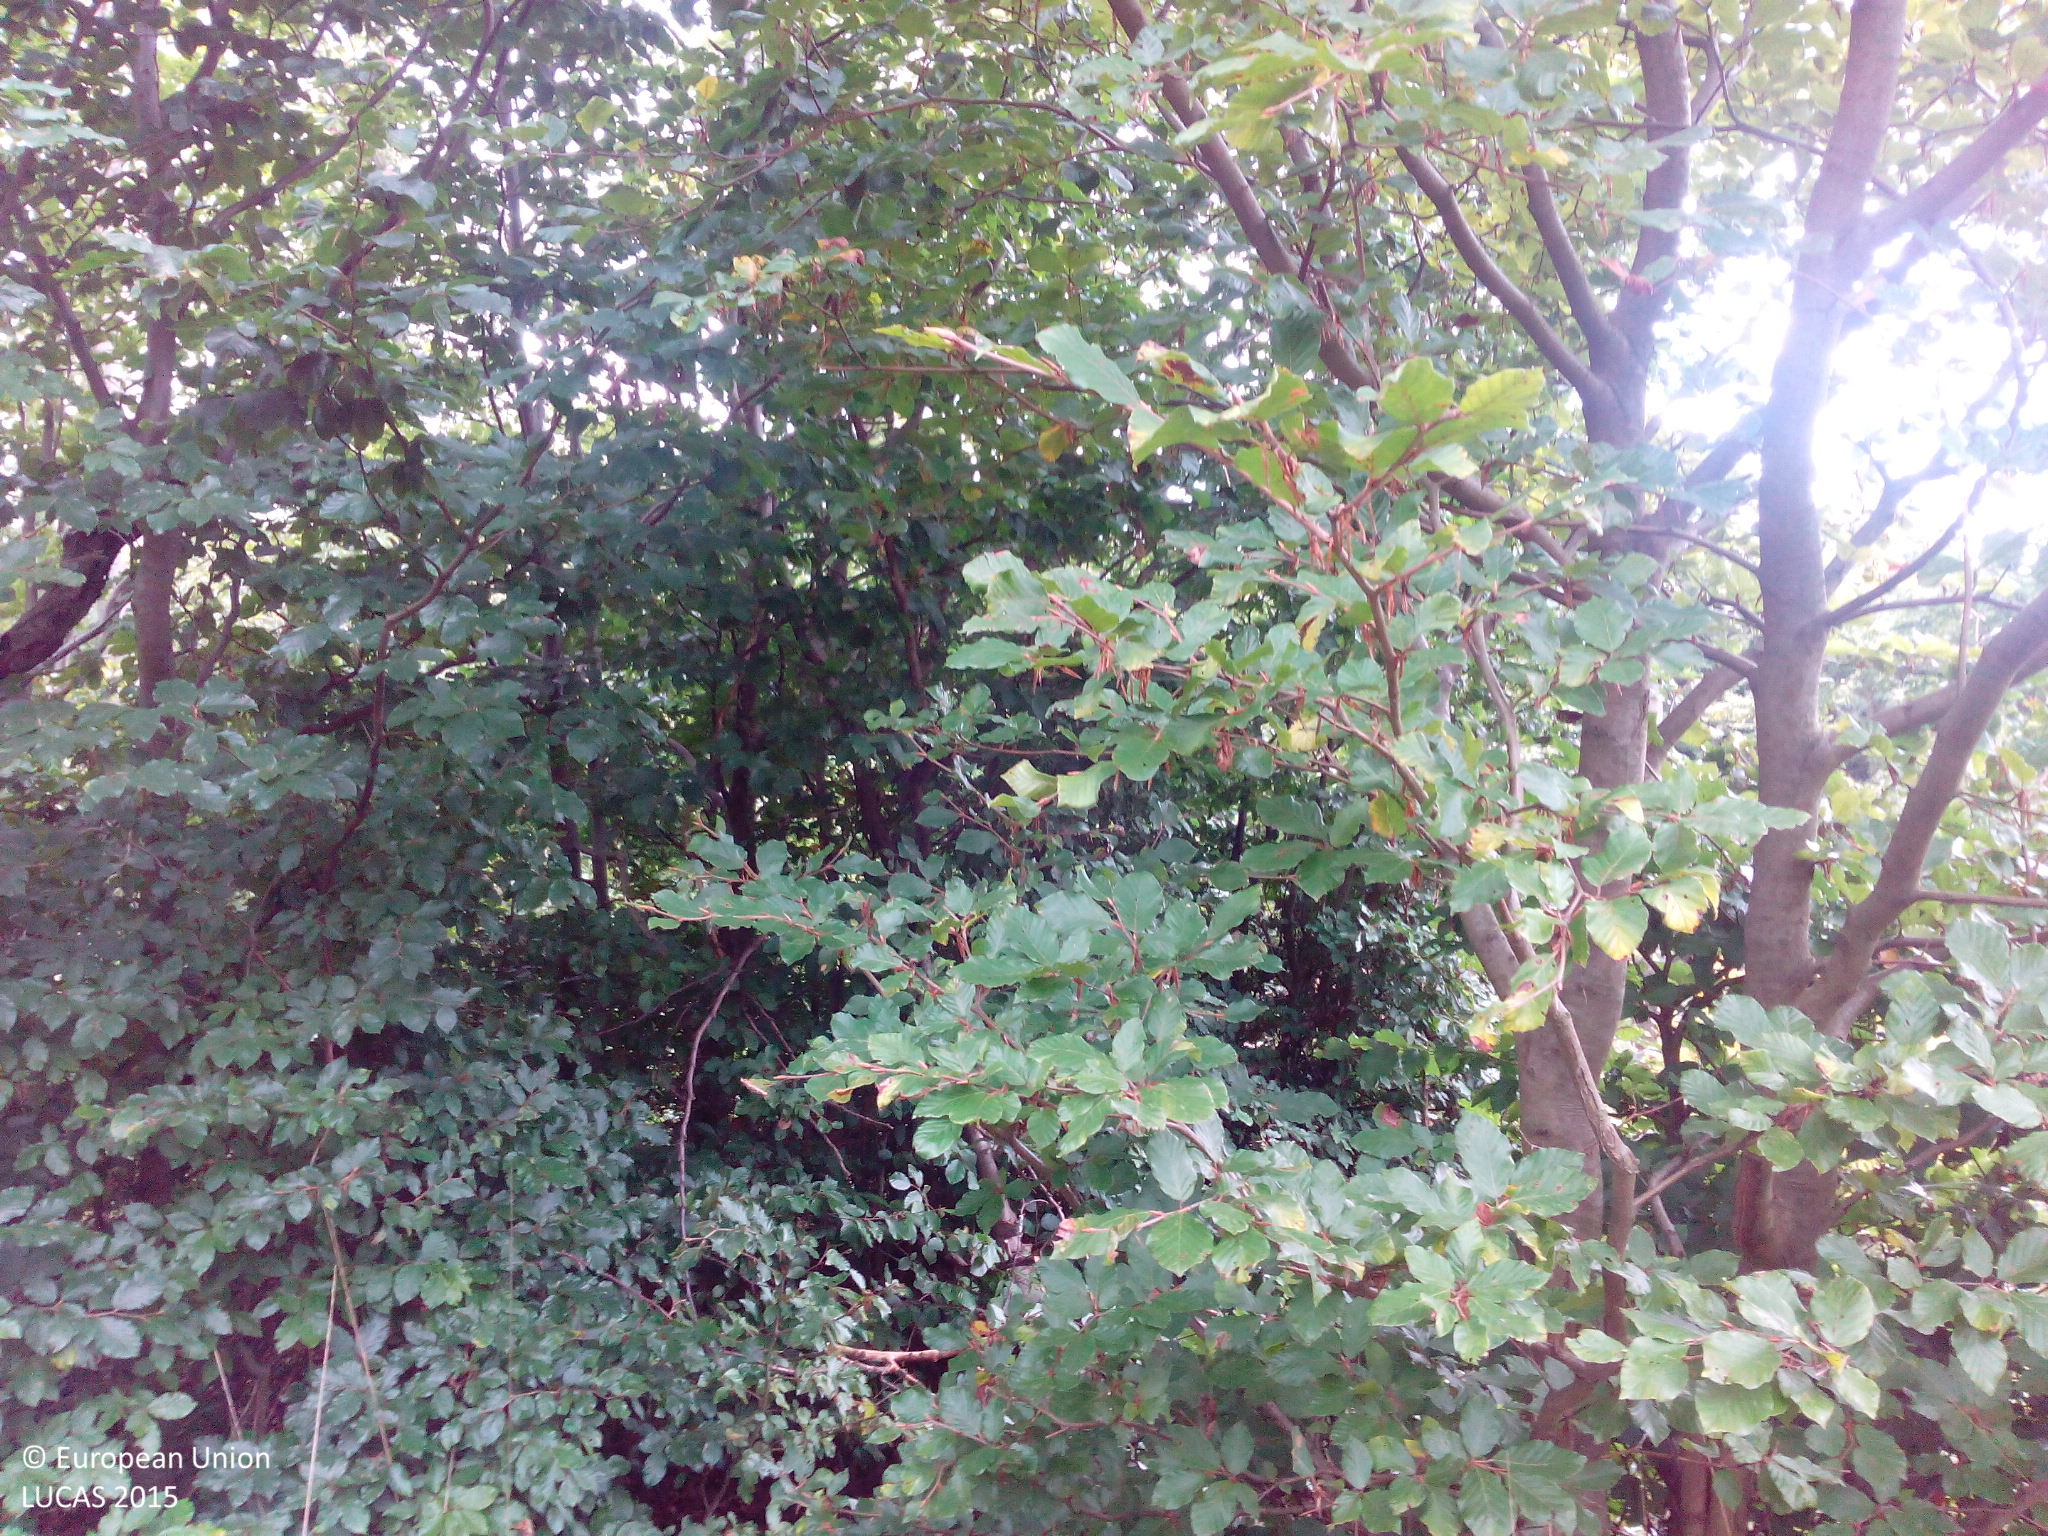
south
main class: Woodland
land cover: Broadleaved woodland
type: beech forest
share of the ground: 50 - 75 %
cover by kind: broadleaved forest trees 70 %, herbaceous plants 30 %
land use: Forestry
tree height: > 5 m
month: September
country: DE
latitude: 51.6005
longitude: 10.9670
